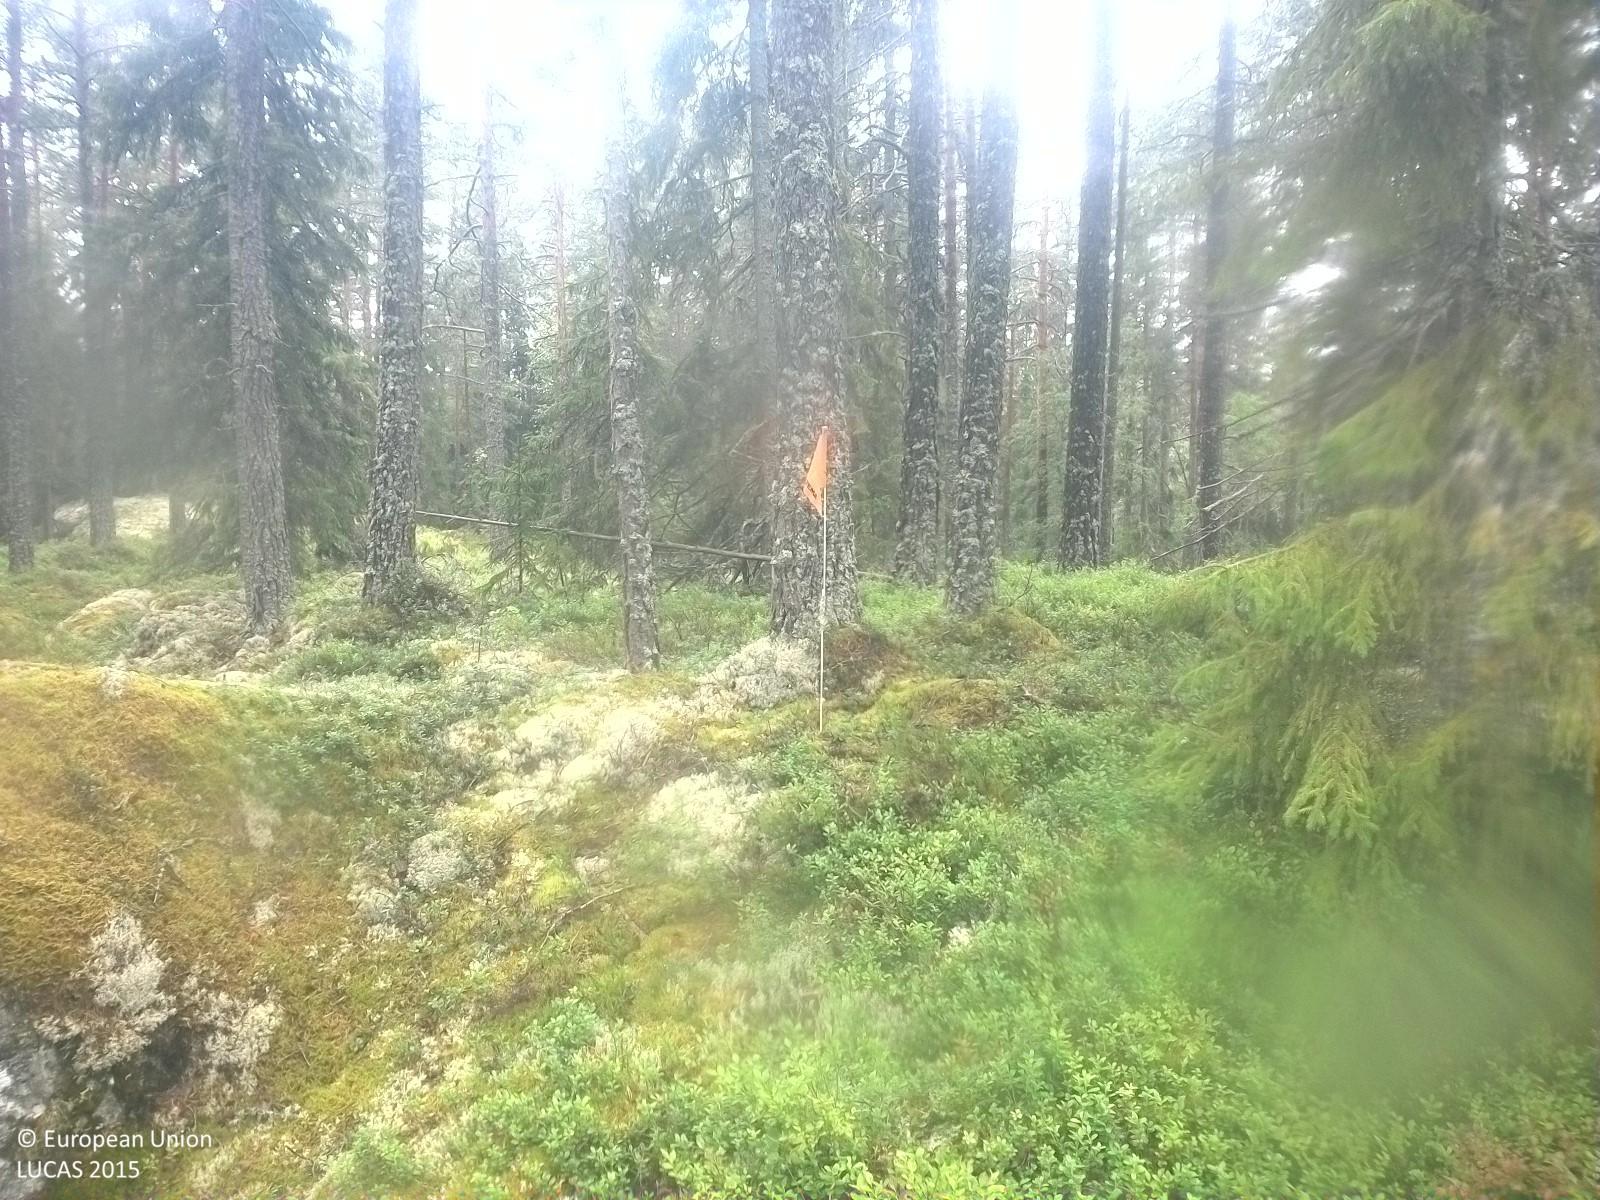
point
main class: Woodland
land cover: Pine dominated coniferous woodland
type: boreal forest
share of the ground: 10 - 25 %
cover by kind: herbaceous plants 60 %, coniferous forest trees 20 %, shrubs 10 %, lichens and mosses 10 %
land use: Forestry
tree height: > 5 m
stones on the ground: 25 - 50 %
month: July
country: SE
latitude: 58.7707
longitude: 15.1289
